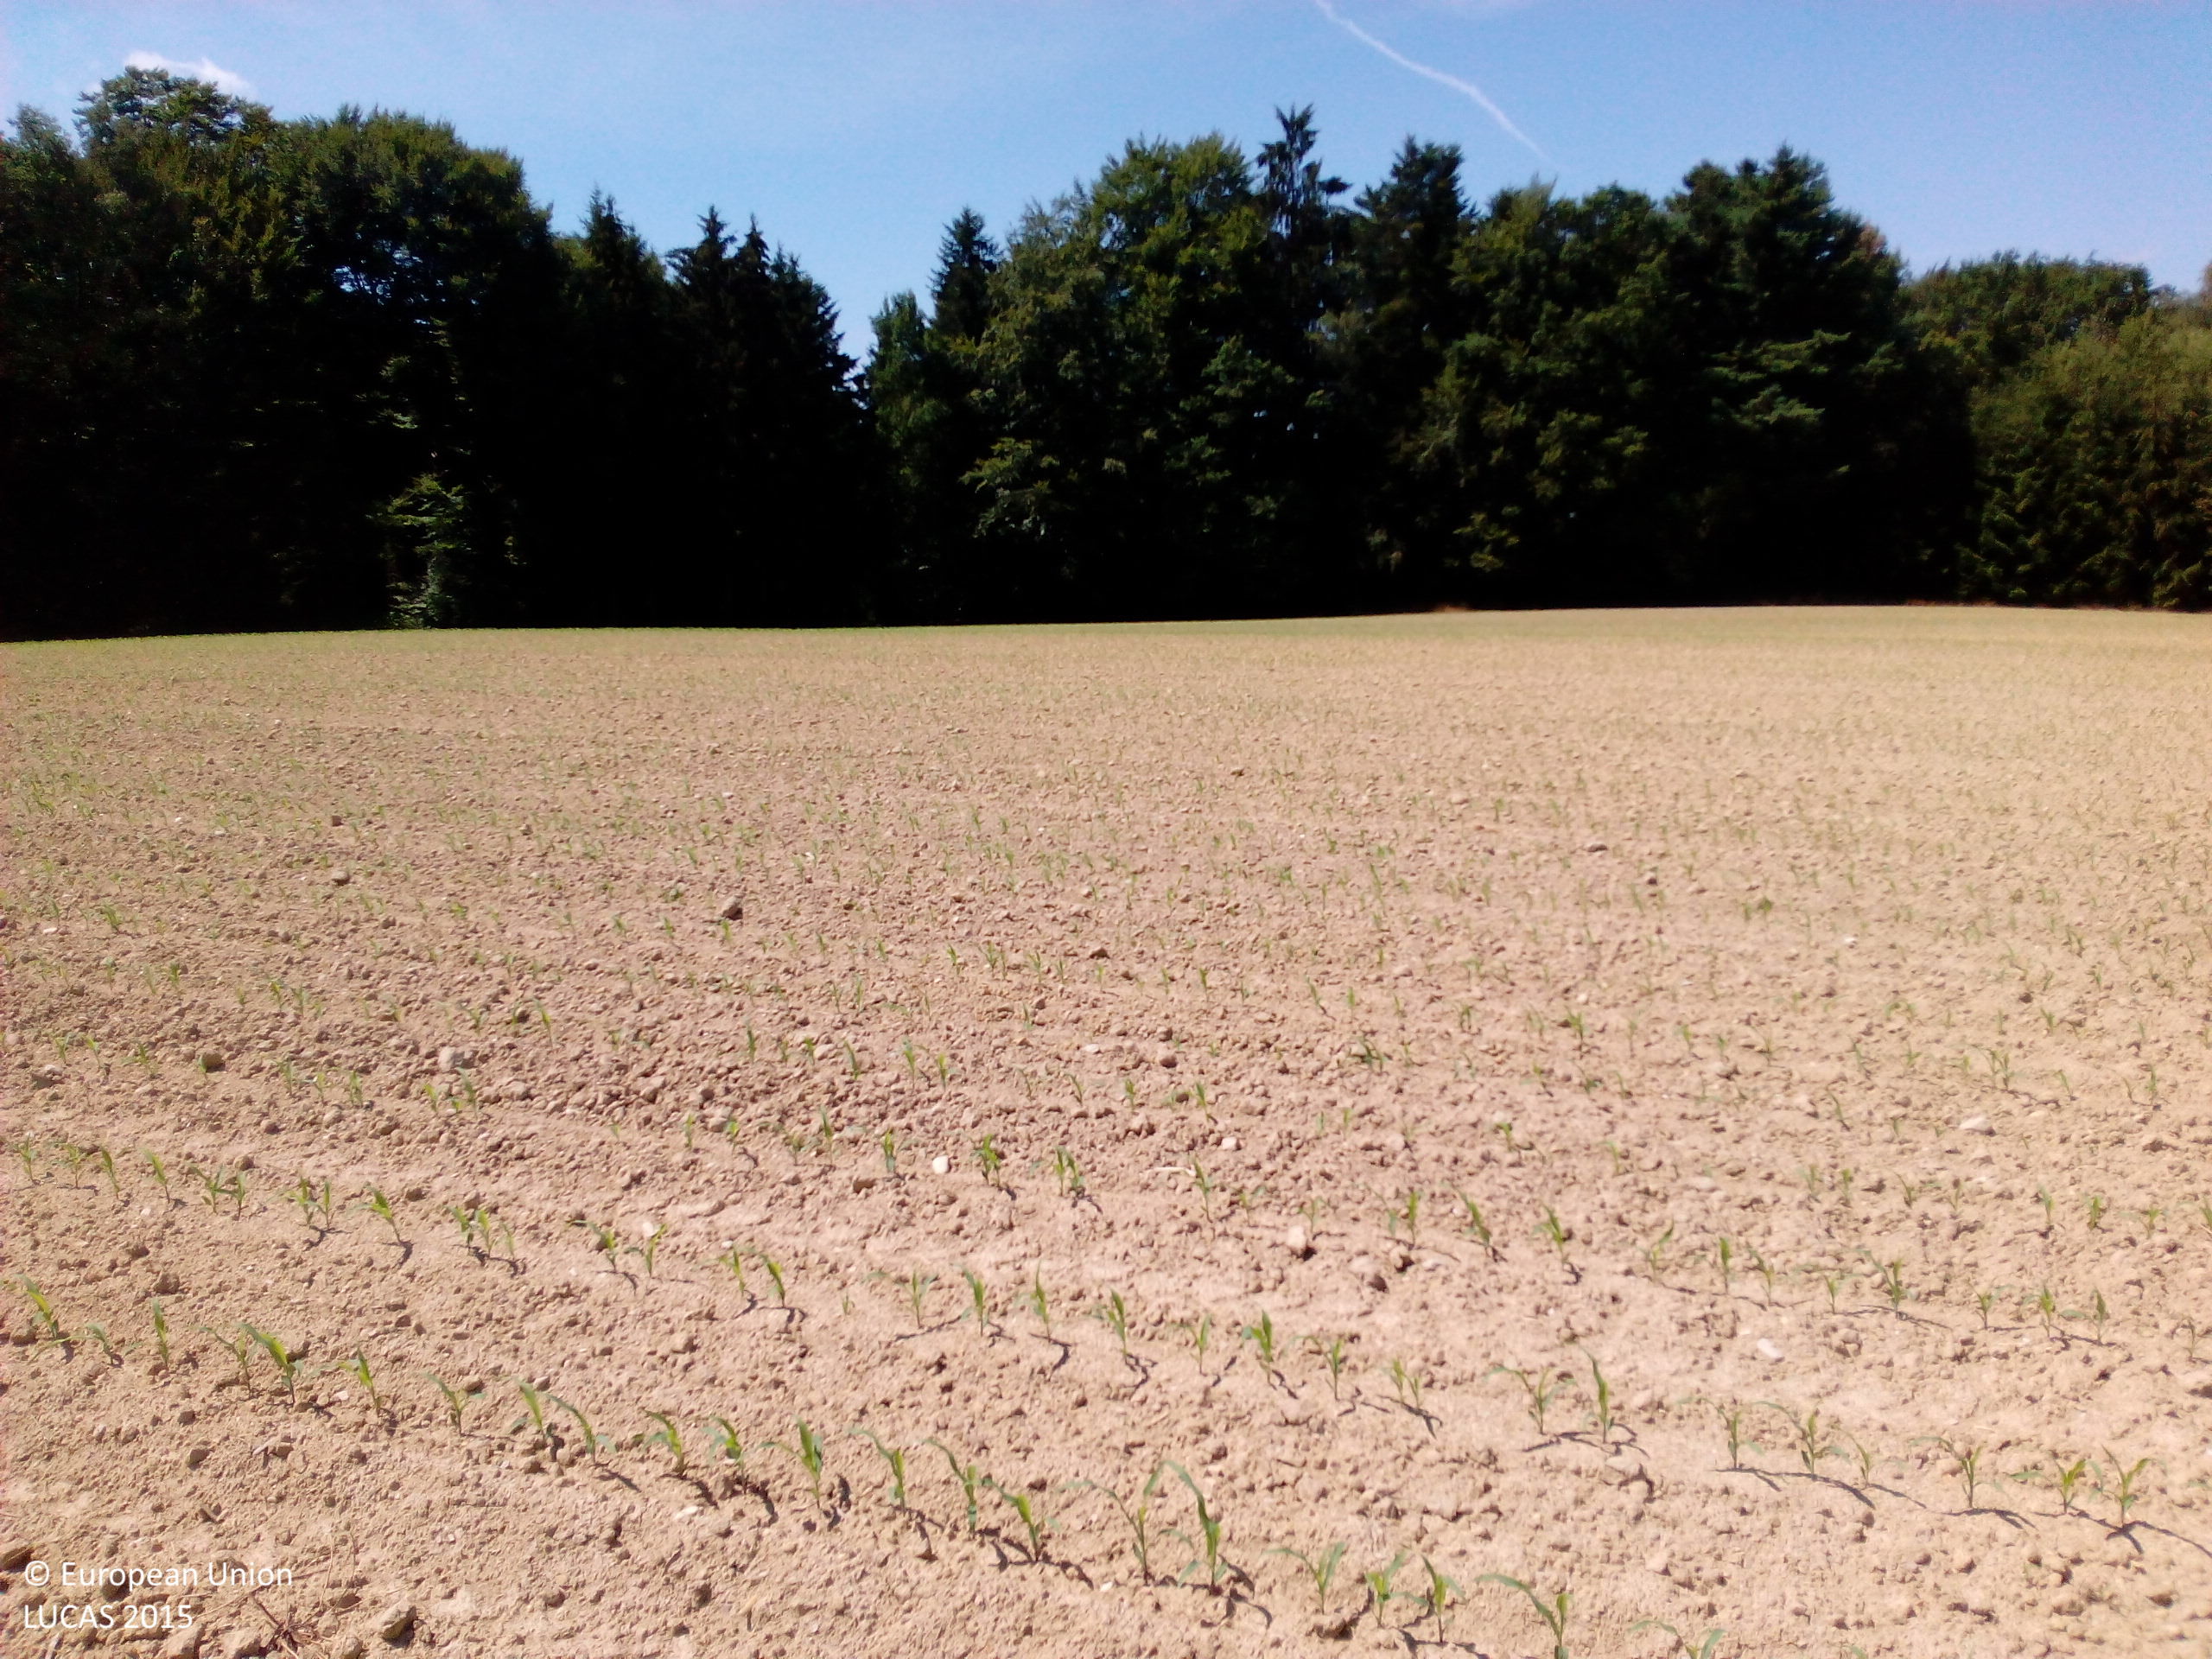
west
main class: Cropland
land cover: Maize
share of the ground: < 10 %
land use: Agriculture (excluding fallow land and kitchen gardens)
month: July
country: DE
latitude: 48.5894
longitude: 13.2668
